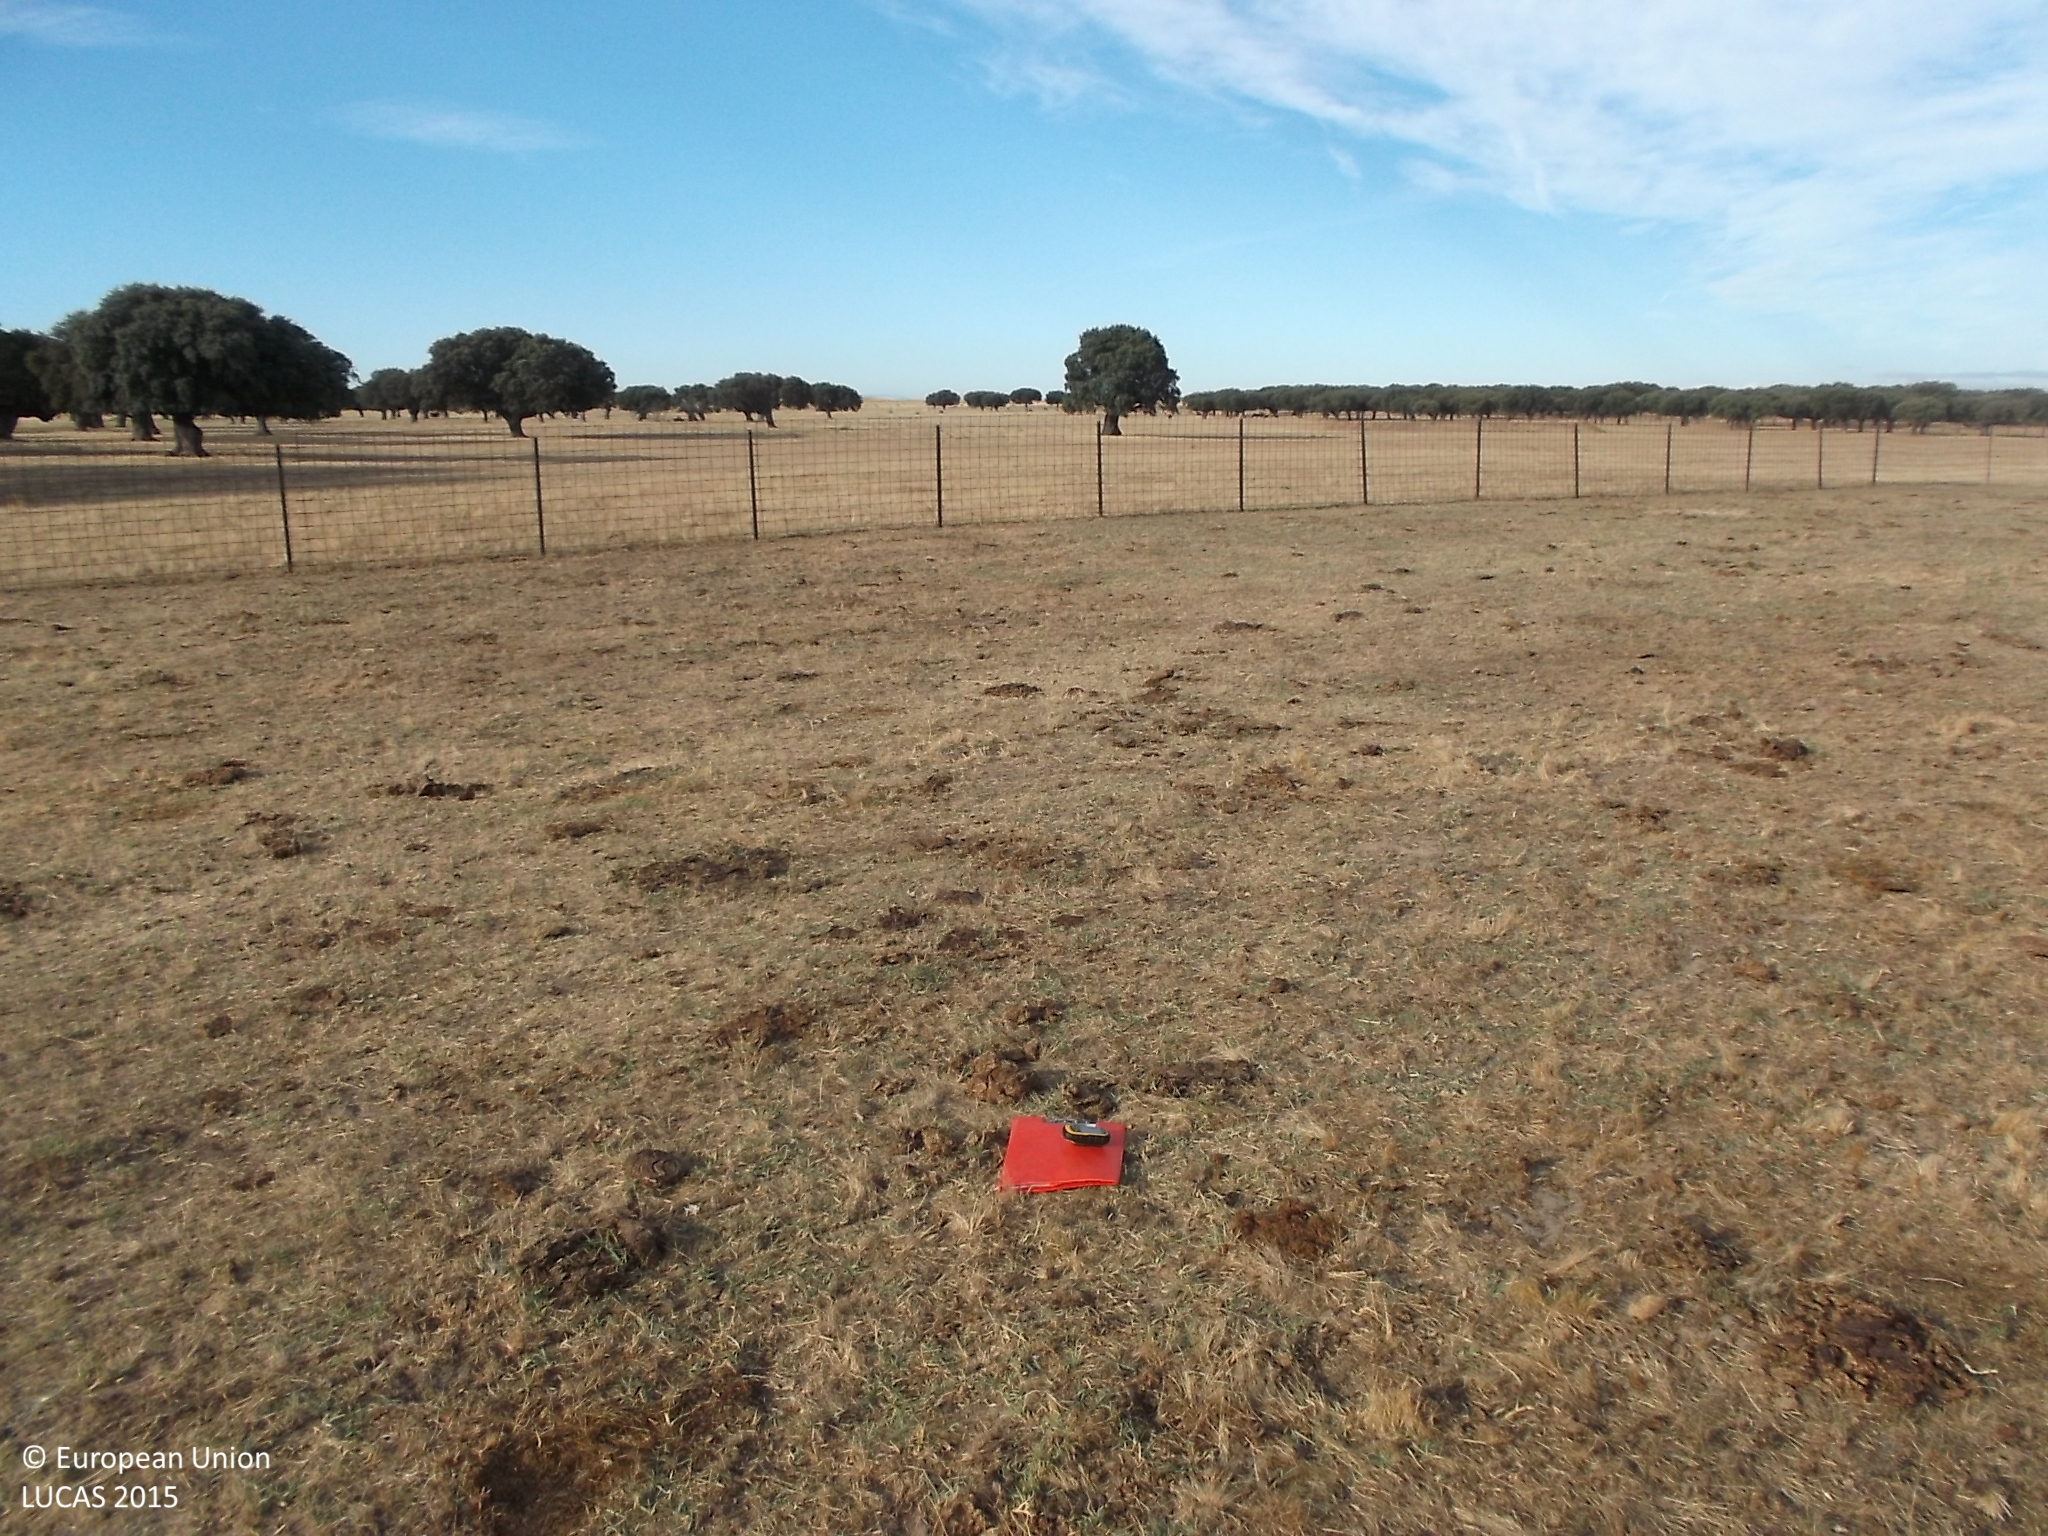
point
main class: Grassland
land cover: Grassland without tree/shrub cover
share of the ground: > 75 %
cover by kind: herbaceous plants 100 %
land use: Agriculture (excluding fallow land and kitchen gardens)
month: July
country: ES
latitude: 40.8309
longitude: -6.2743
